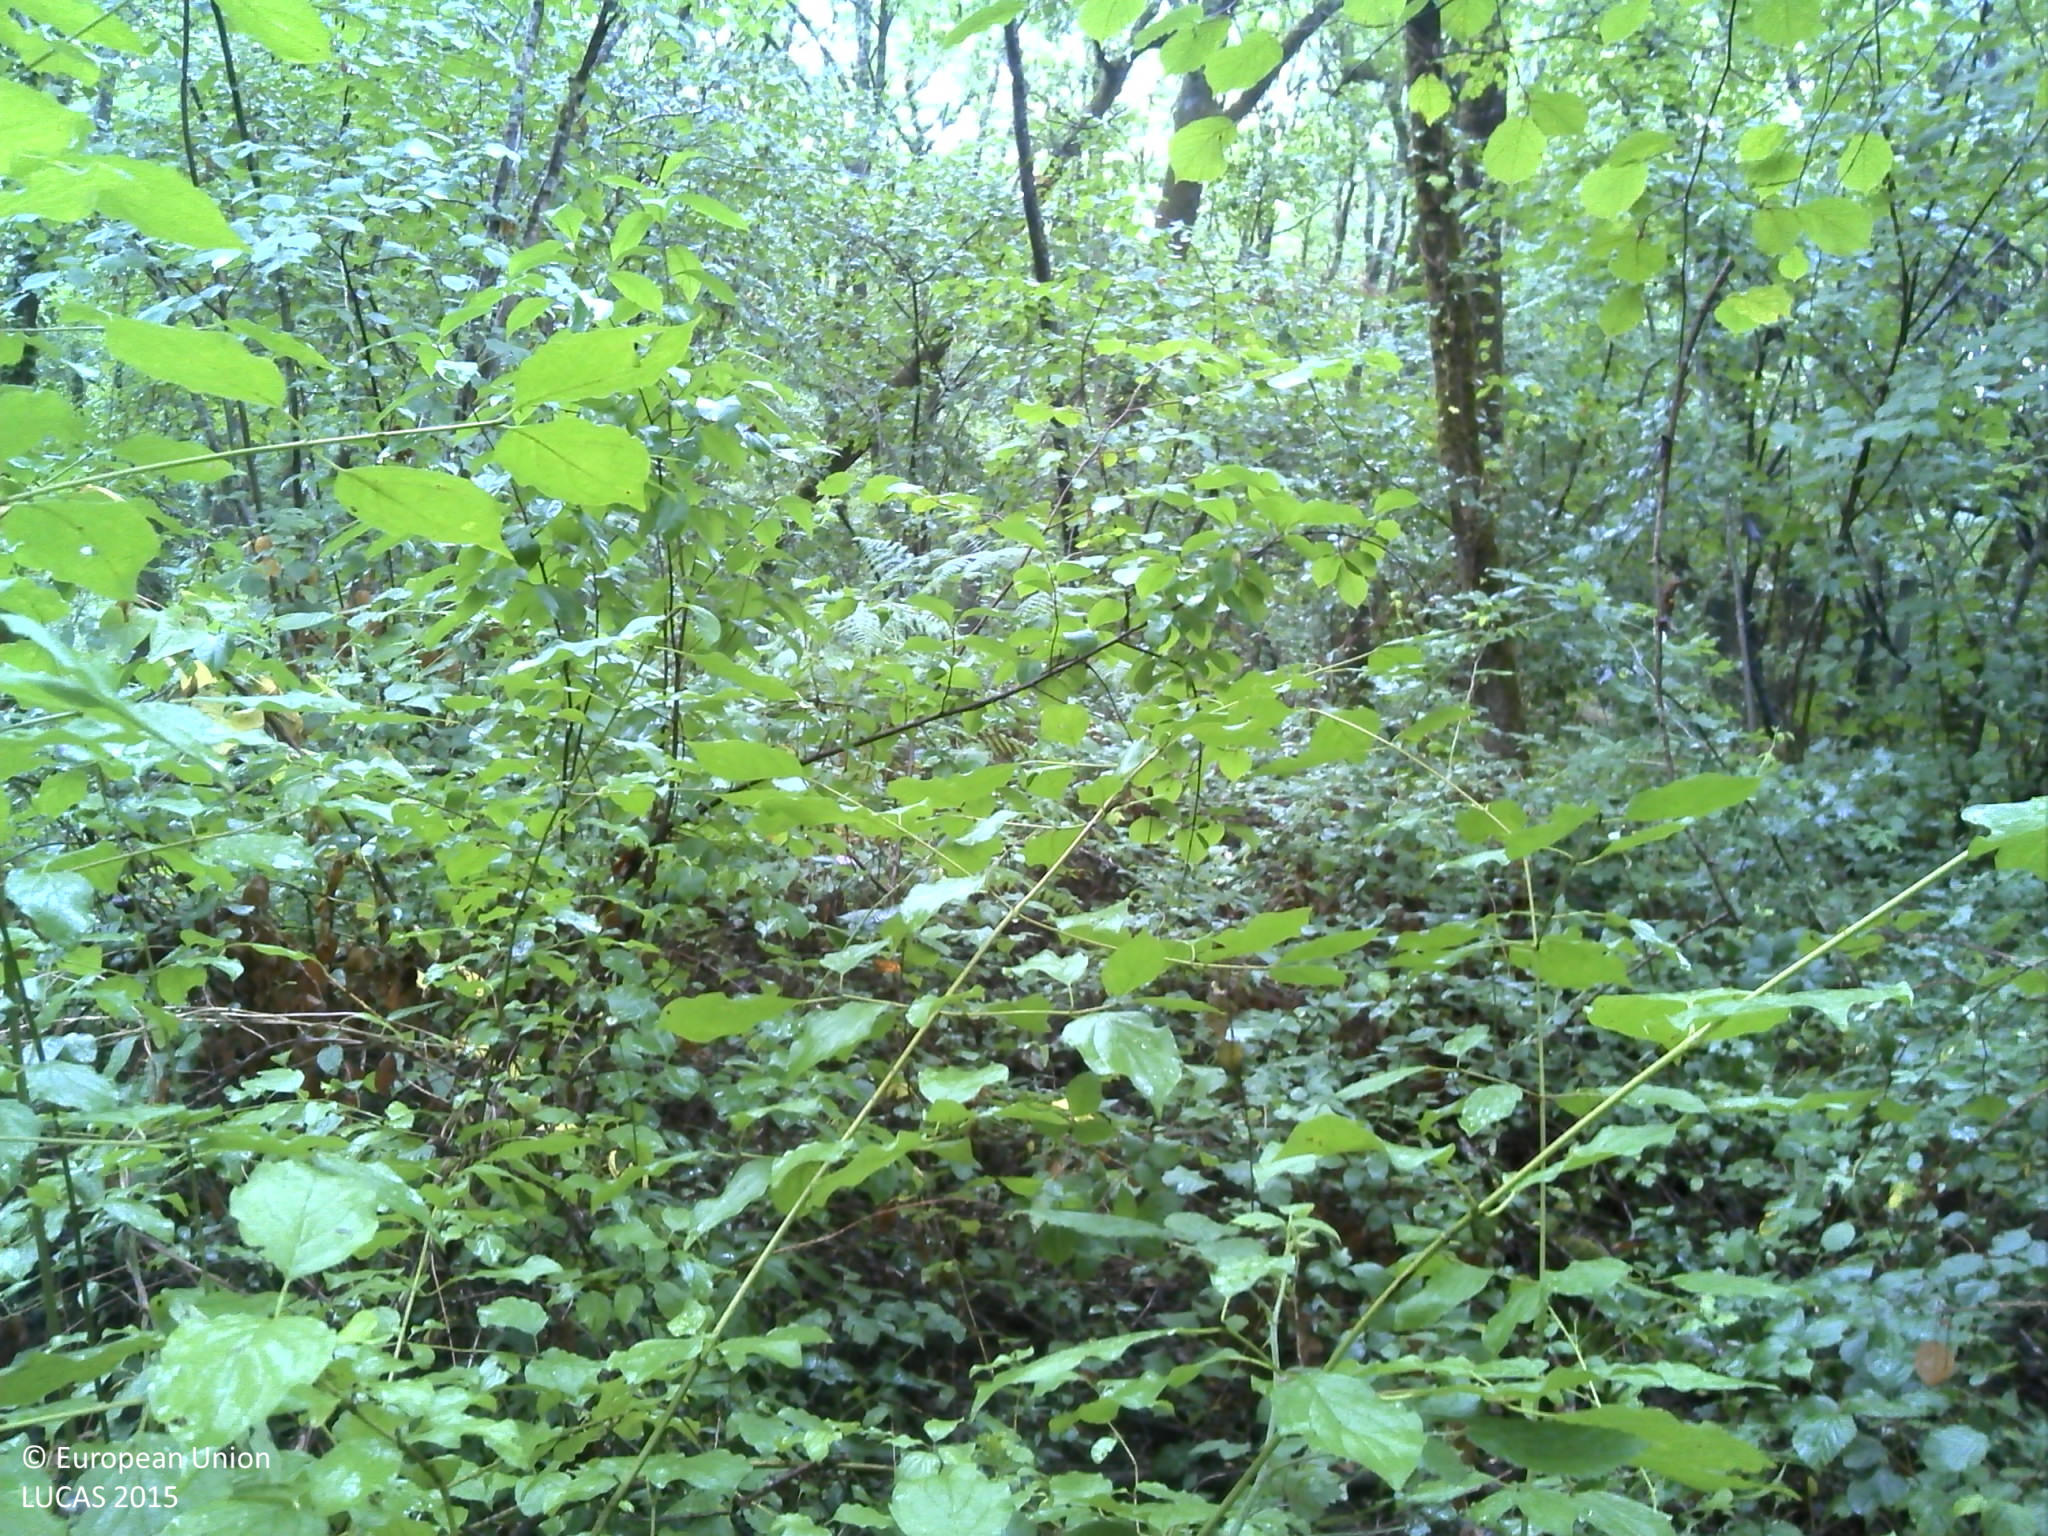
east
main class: Woodland
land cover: Broadleaved woodland
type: floodplain forest
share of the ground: > 75 %
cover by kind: broadleaved forest trees 70 %, shrubs 20 %, herbaceous plants 5 %, lichens and mosses 5 %
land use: Semi-natural and natural areas not in use
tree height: > 5 m
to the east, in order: Broadleaved woodland; Inland fresh running water; Broadleaved woodland; Inland fresh running water; Broadleaved woodland; Tracks; Broadleaved woodland; Spontaneously vegetated surfaces; Grass margins; Electric lines; Paved roads, cycling and walking lanes; Grass margins
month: July
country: FR
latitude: 44.6121
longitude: -0.5388
